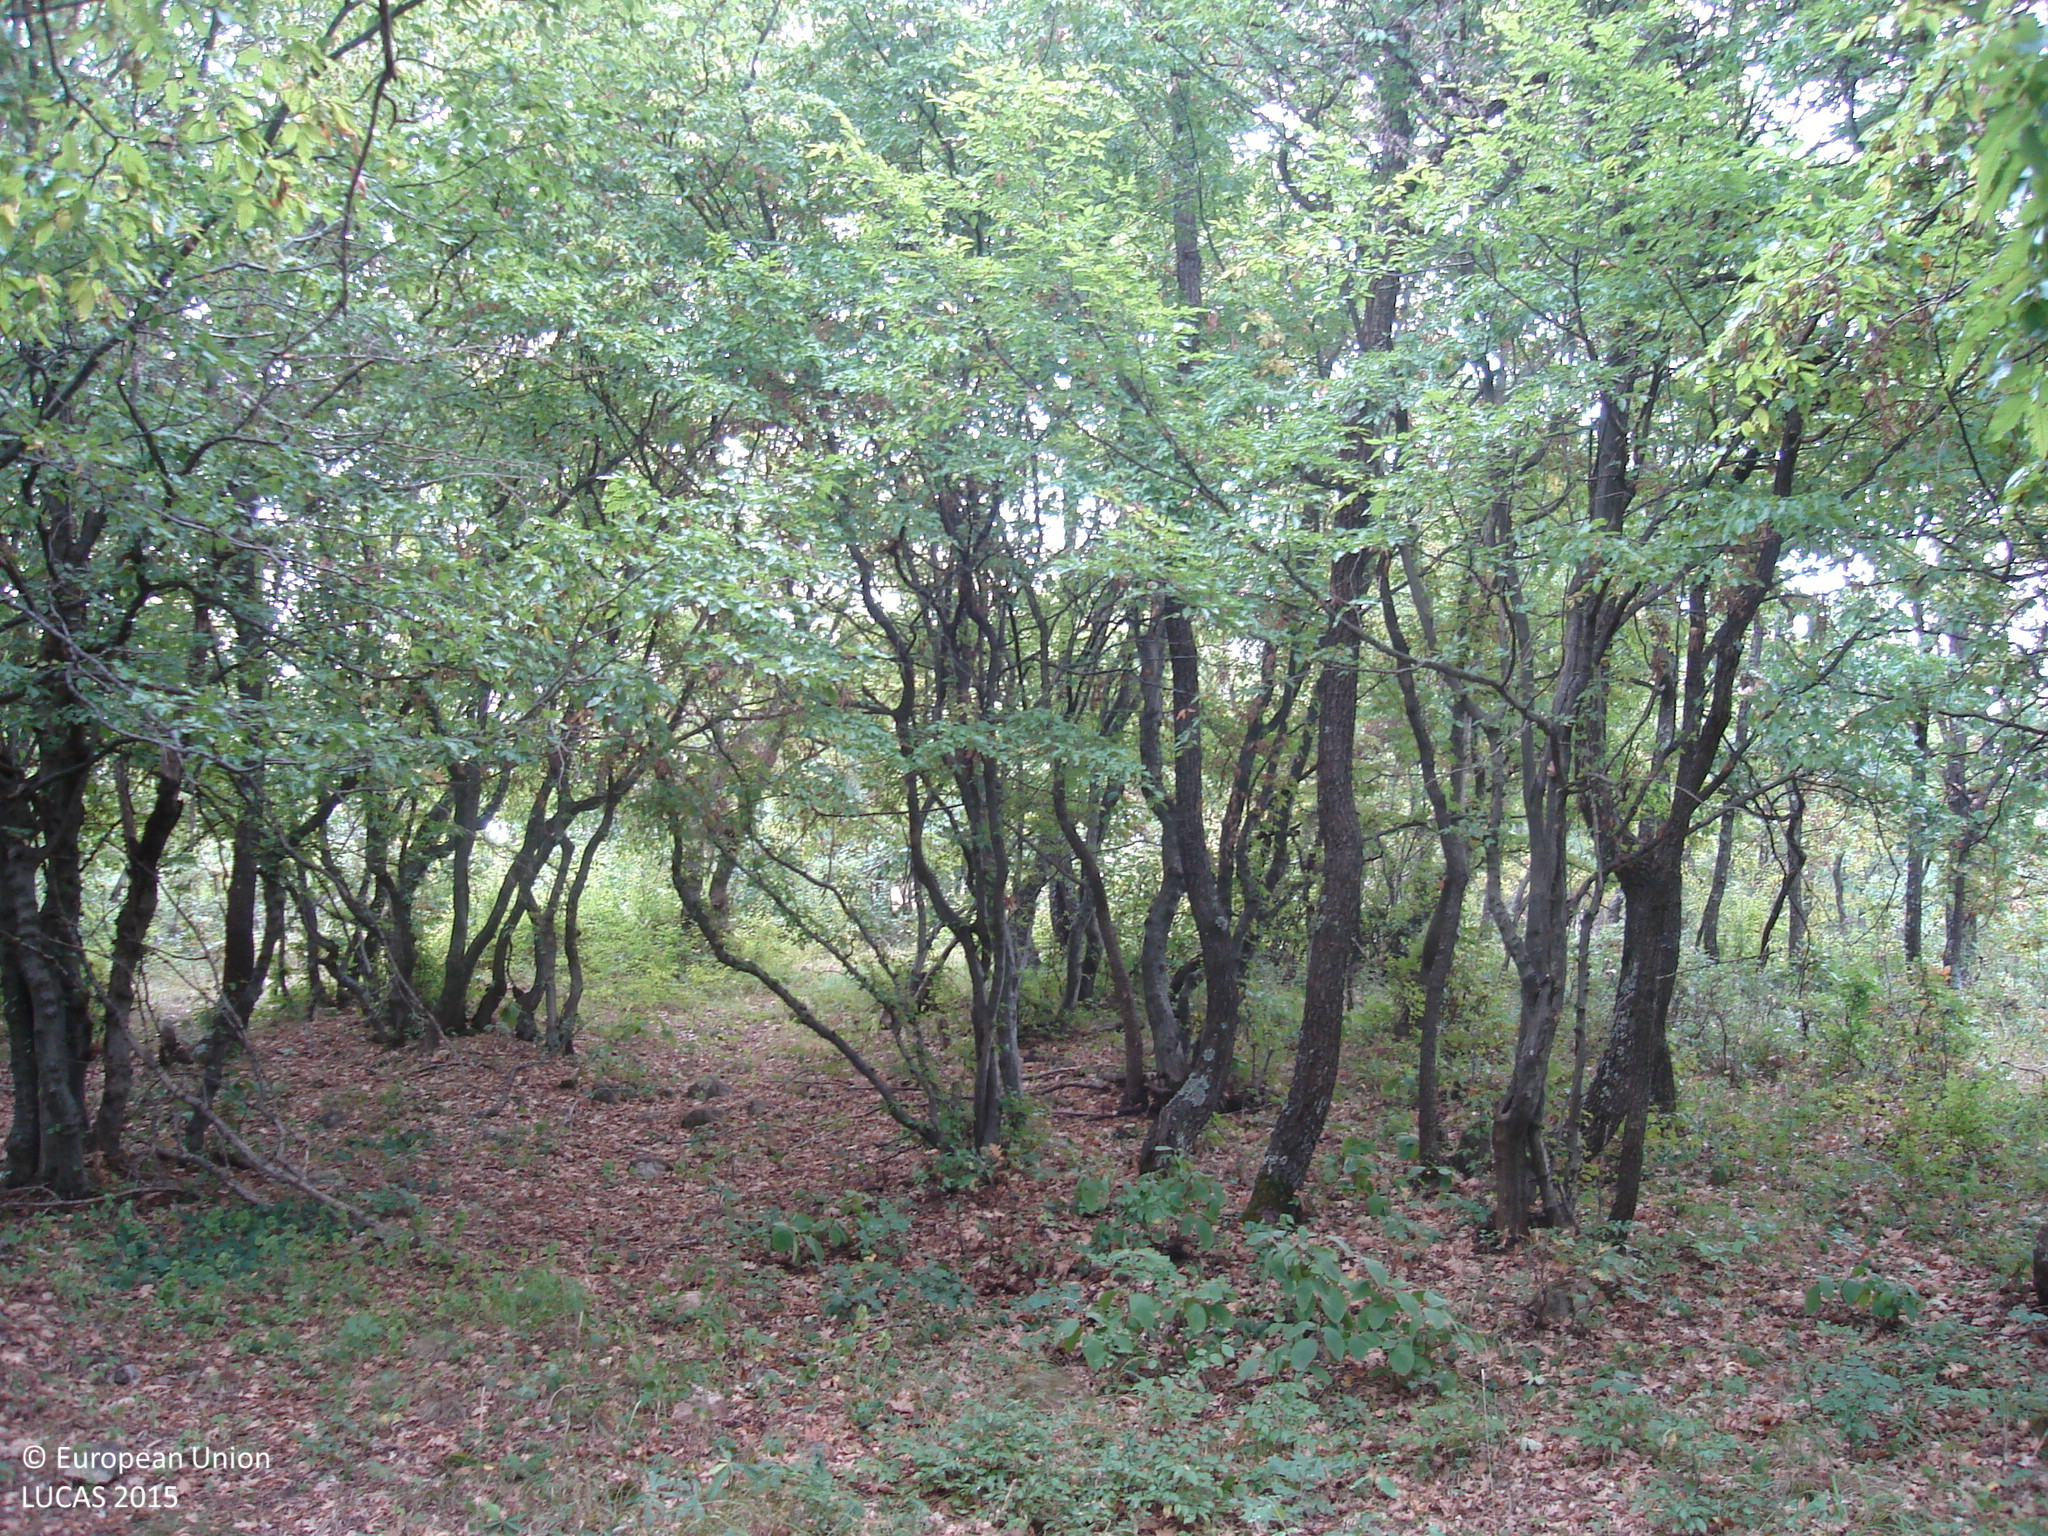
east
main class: Woodland
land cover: Broadleaved woodland
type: thermophilous deciduous forest
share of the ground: 50 - 75 %
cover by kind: broadleaved forest trees 65 %, herbaceous plants 25 %, shrubs 5 %, consolidated bare surface 5 %
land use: Forestry
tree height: > 5 m
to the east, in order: Broadleaved woodland; Grassland without tree/shrub cover; Groves; Grassland without tree/shrub cover; Broadleaved woodland; Grassland without tree/shrub cover
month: September
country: BG
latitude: 42.6515
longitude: 23.9615
